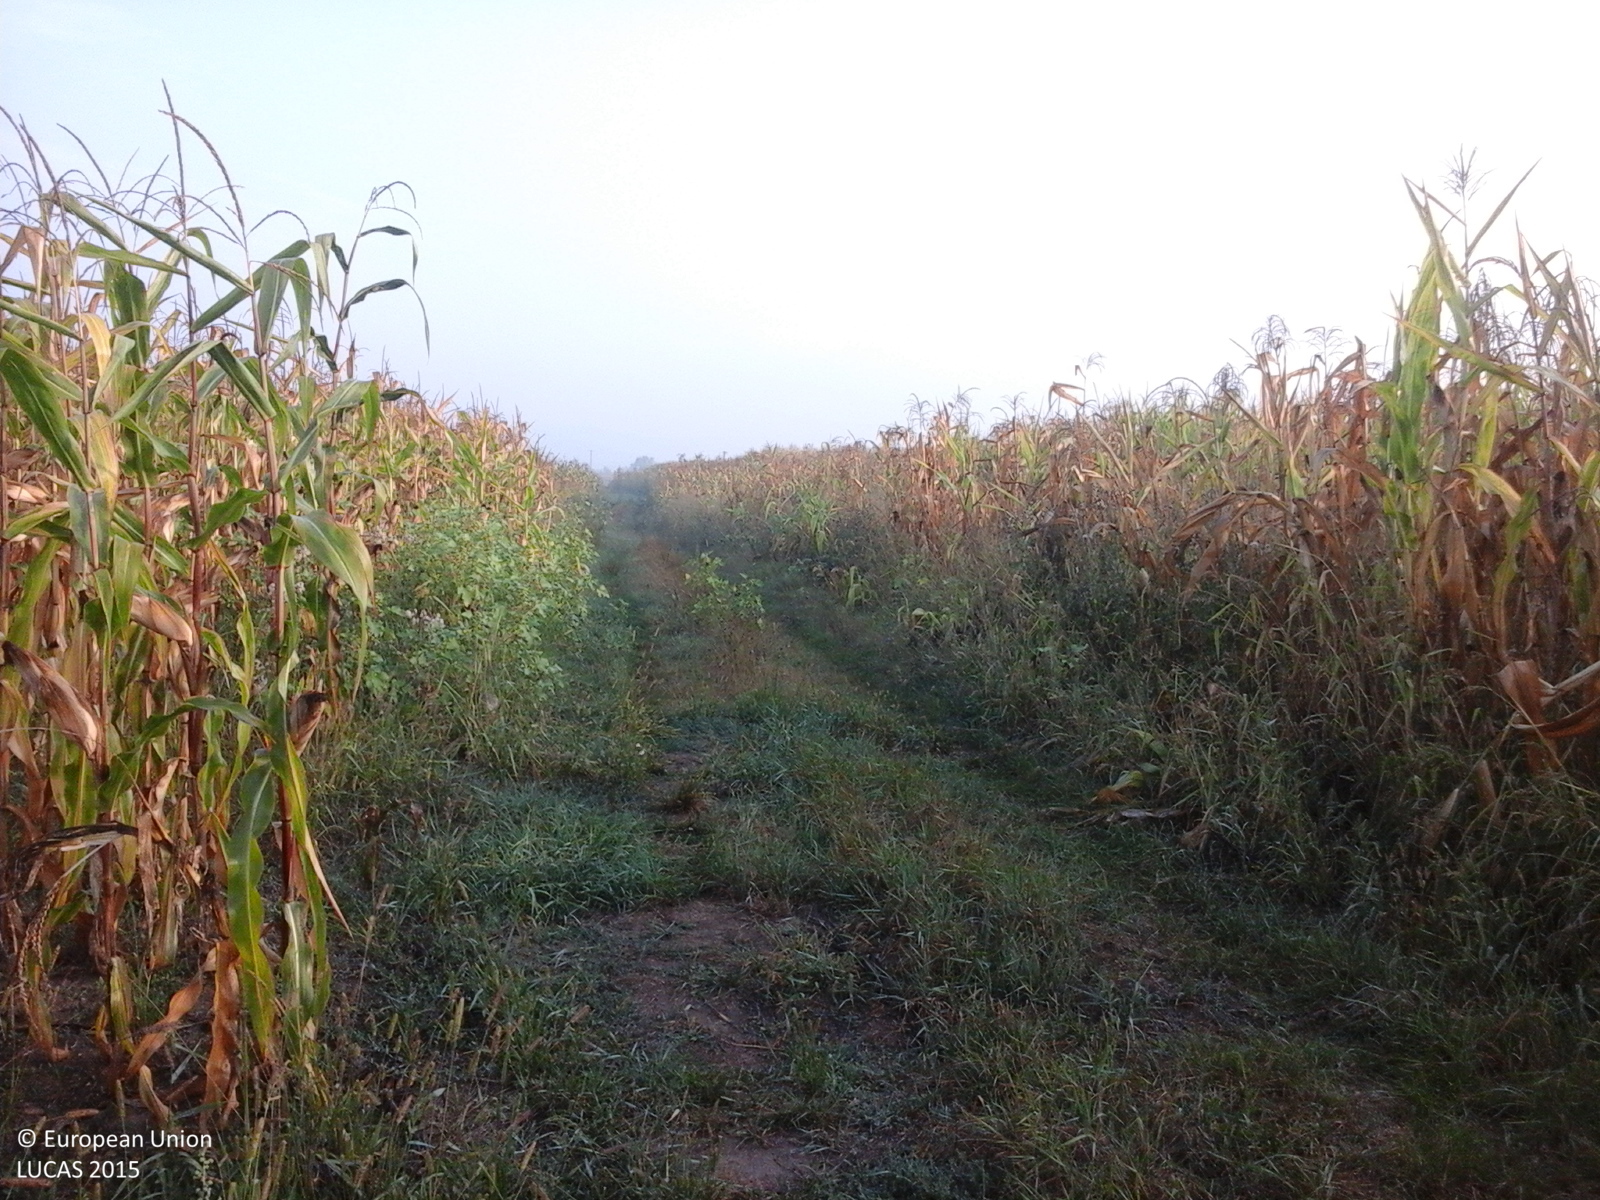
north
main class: Cropland
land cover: Maize
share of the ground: > 75 %
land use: Agriculture (excluding fallow land and kitchen gardens)
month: September
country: RO
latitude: 47.1862
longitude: 24.2196
